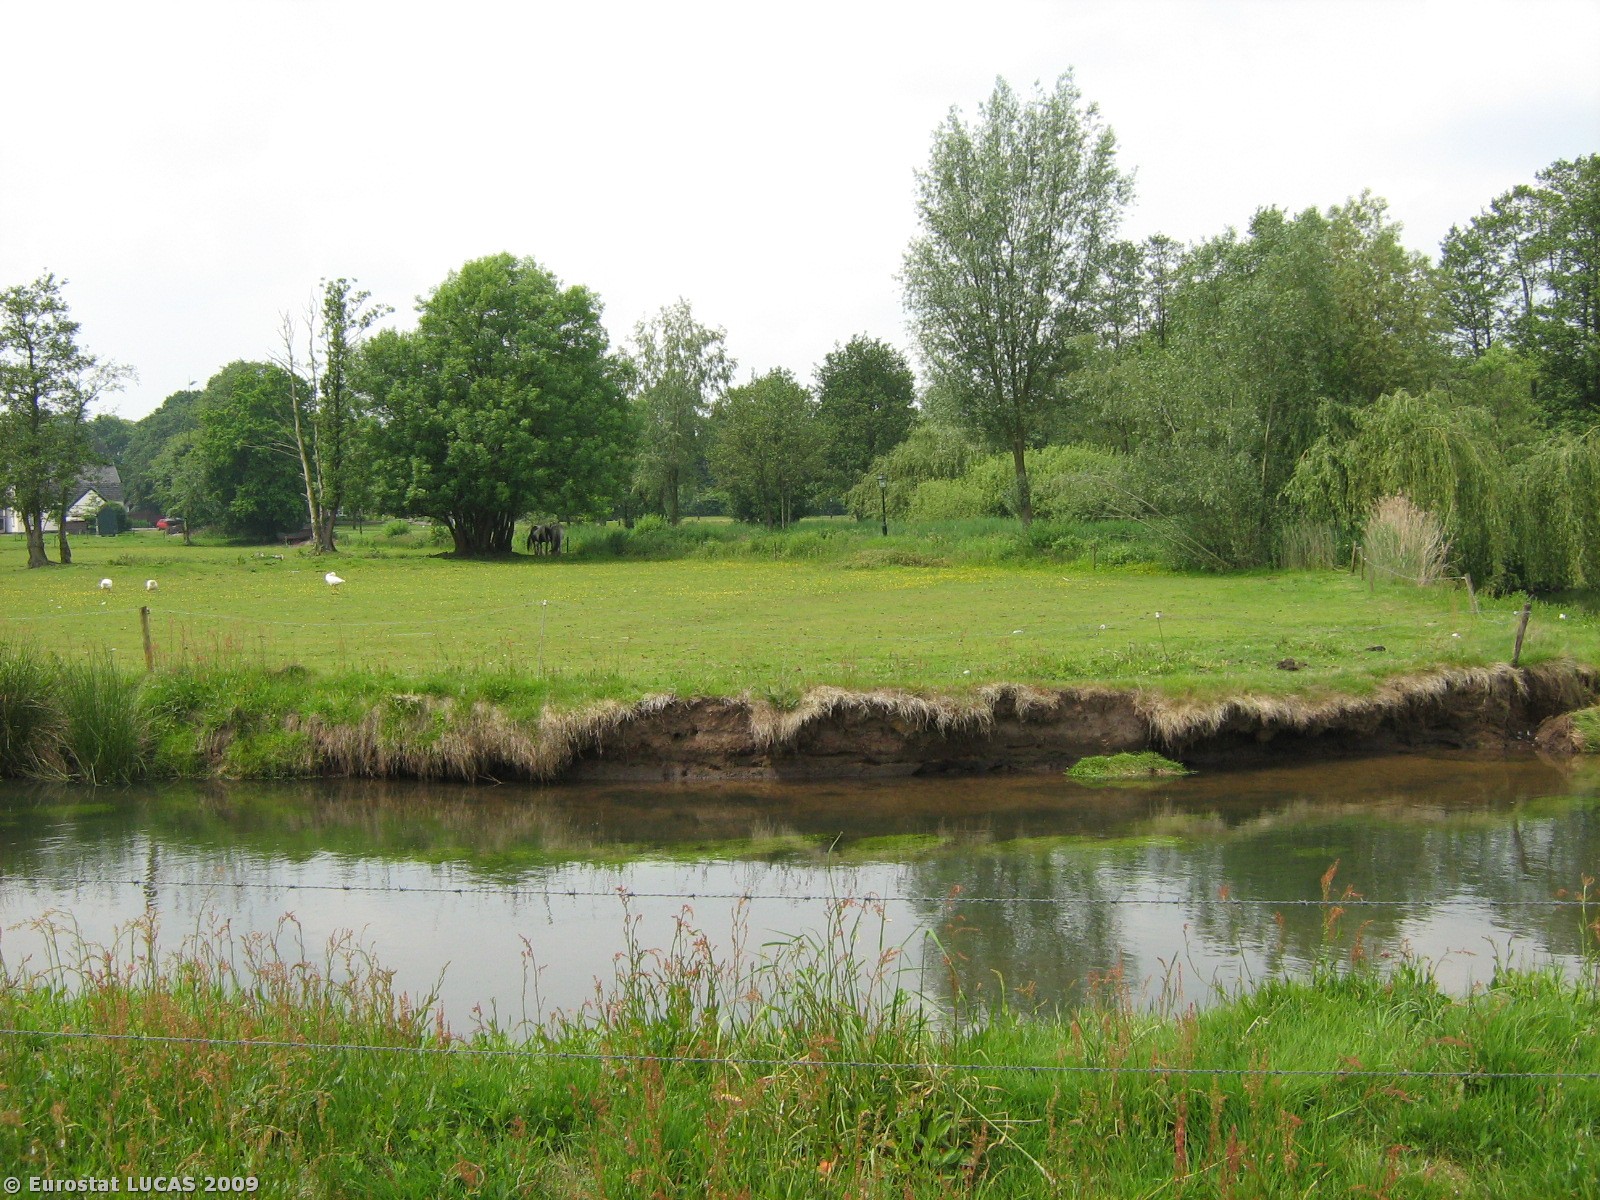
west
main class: Grassland
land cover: Grassland without tree/shrub cover
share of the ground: > 75 %
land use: Nature reserves
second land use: Agriculture (excluding fallow land and kitchen gardens)
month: May
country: NL
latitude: 51.3001
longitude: 5.4514
